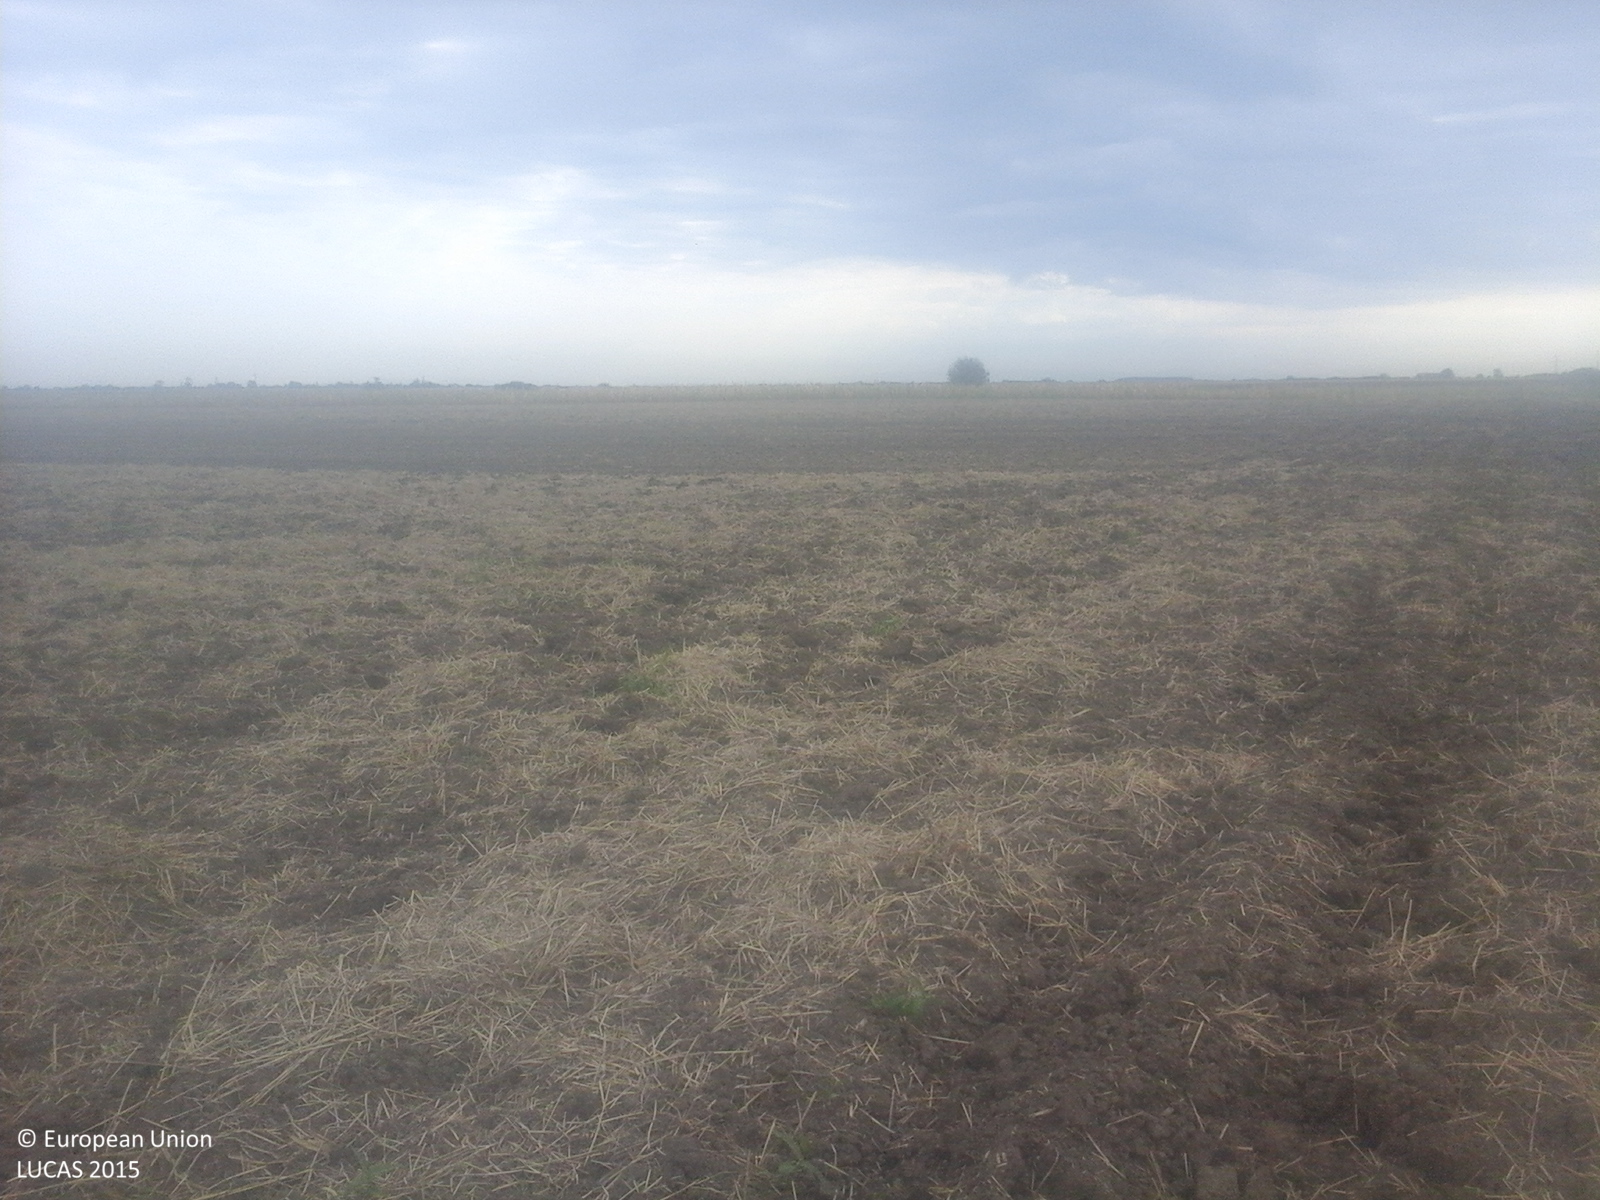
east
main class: Cropland
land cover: Common wheat
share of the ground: < 10 %
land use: Agriculture (excluding fallow land and kitchen gardens)
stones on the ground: < 10 %
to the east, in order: Common wheat; Other bare soil; Common wheat; Maize; Common wheat
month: September
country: RO
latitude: 47.7477
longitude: 22.6381
